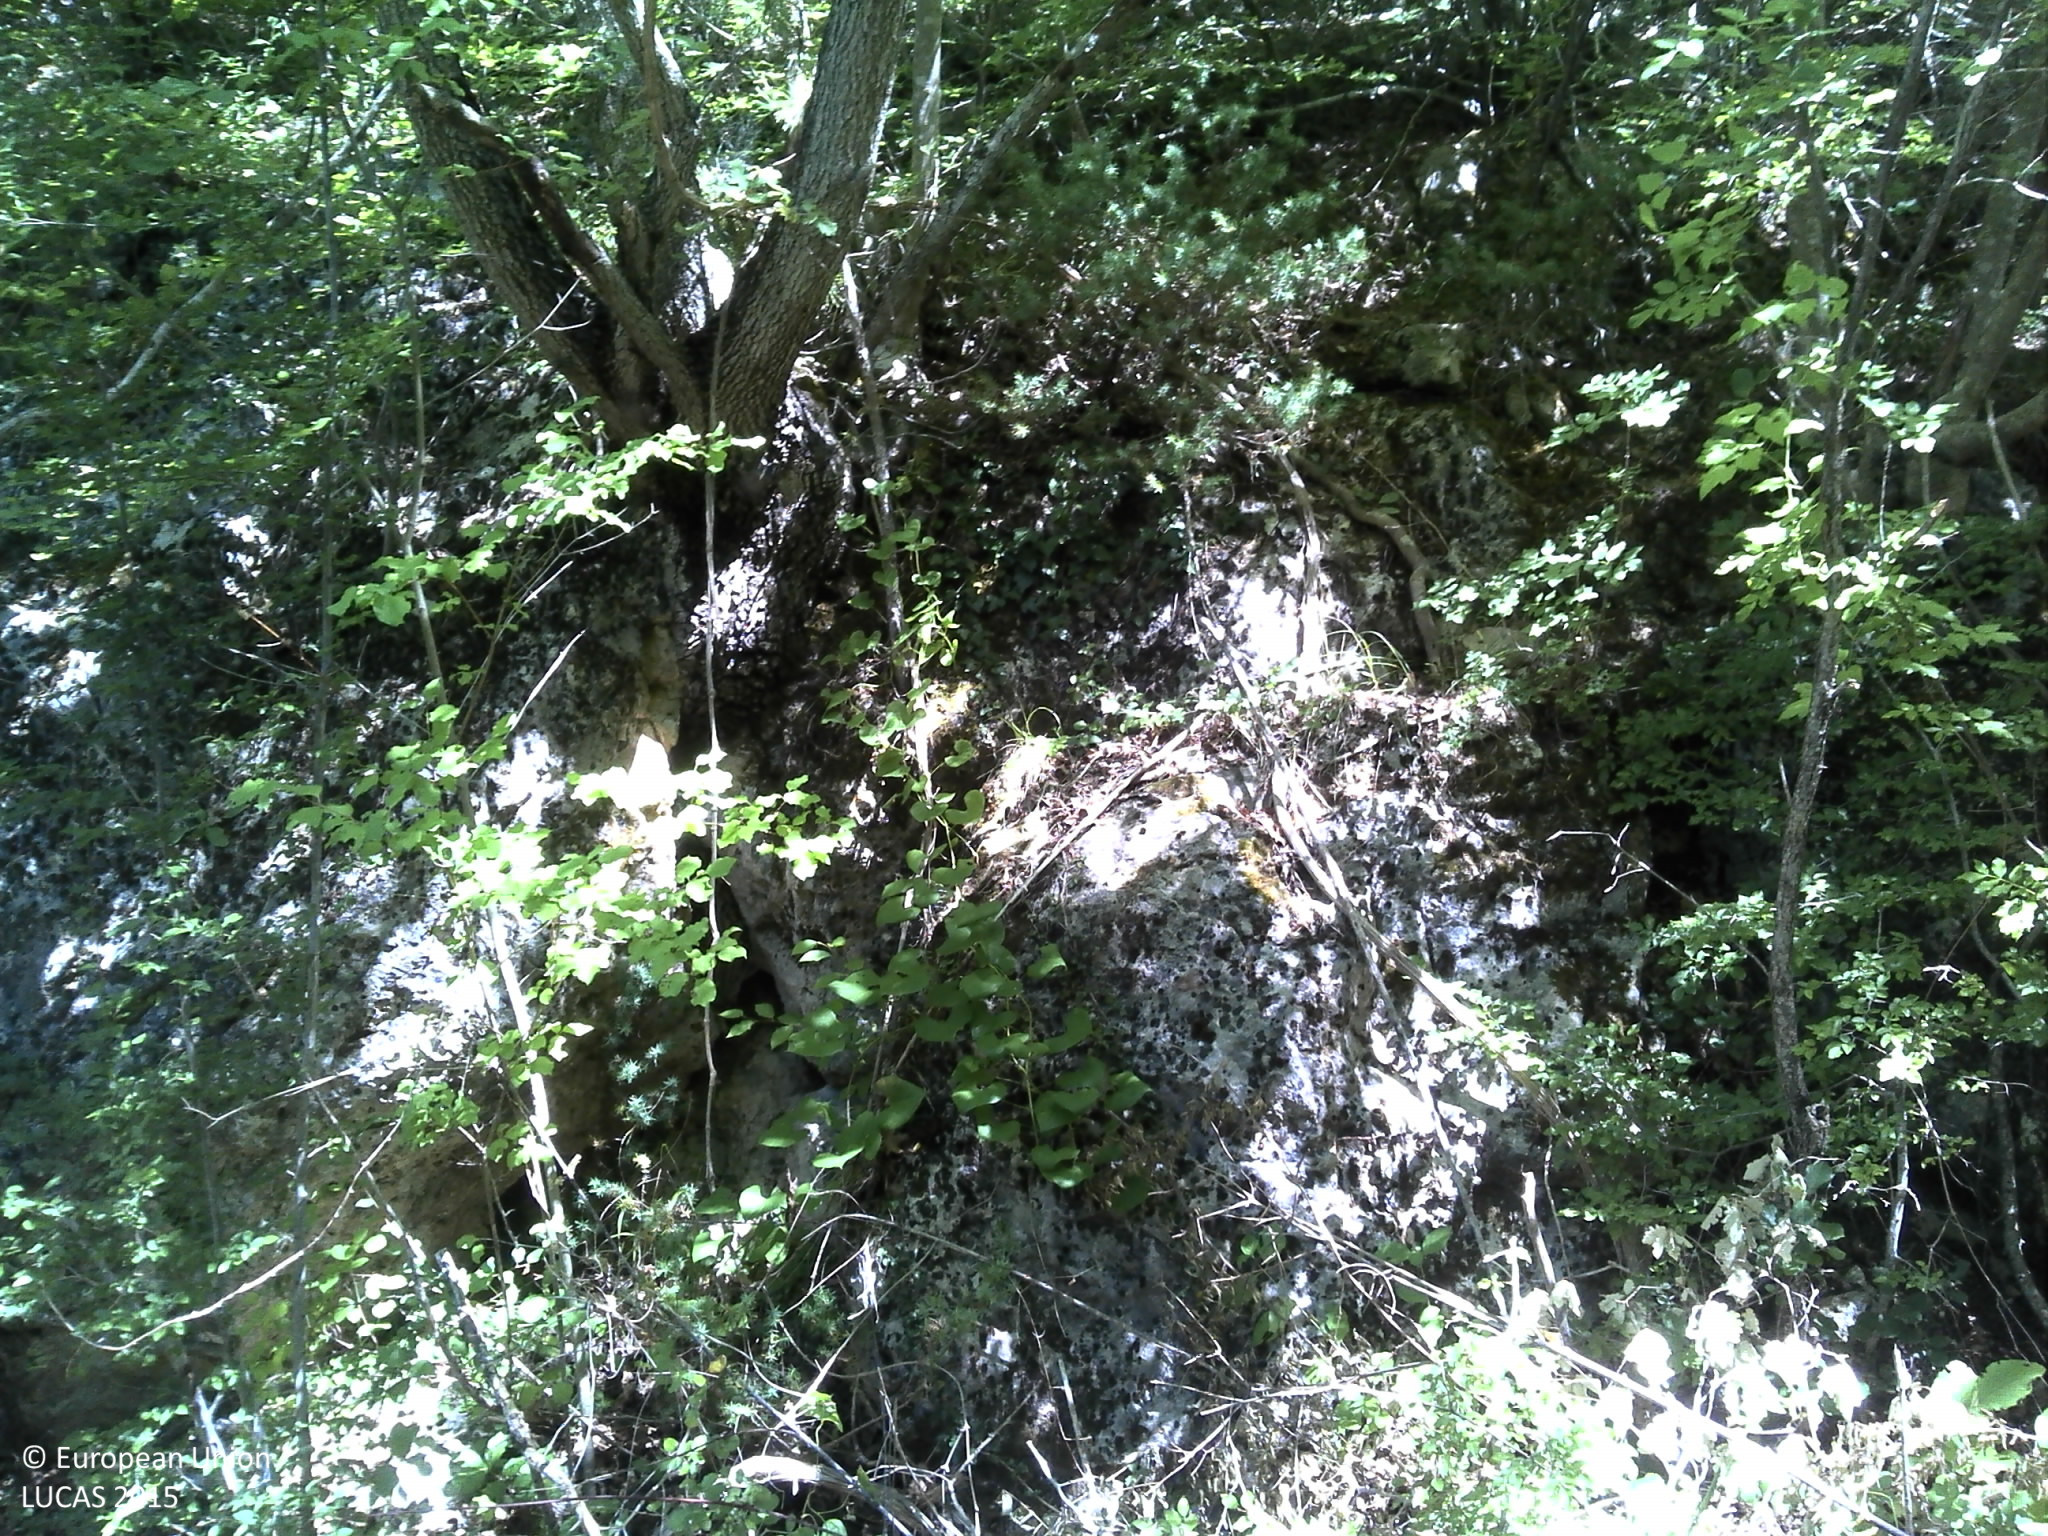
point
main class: Woodland
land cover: Broadleaved woodland
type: beech forest
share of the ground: > 75 %
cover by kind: broadleaved forest trees 90 %, shrubs 10 %
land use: Semi-natural and natural areas not in use
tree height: > 5 m
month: July
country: HR
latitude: 44.1437
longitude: 16.2560
